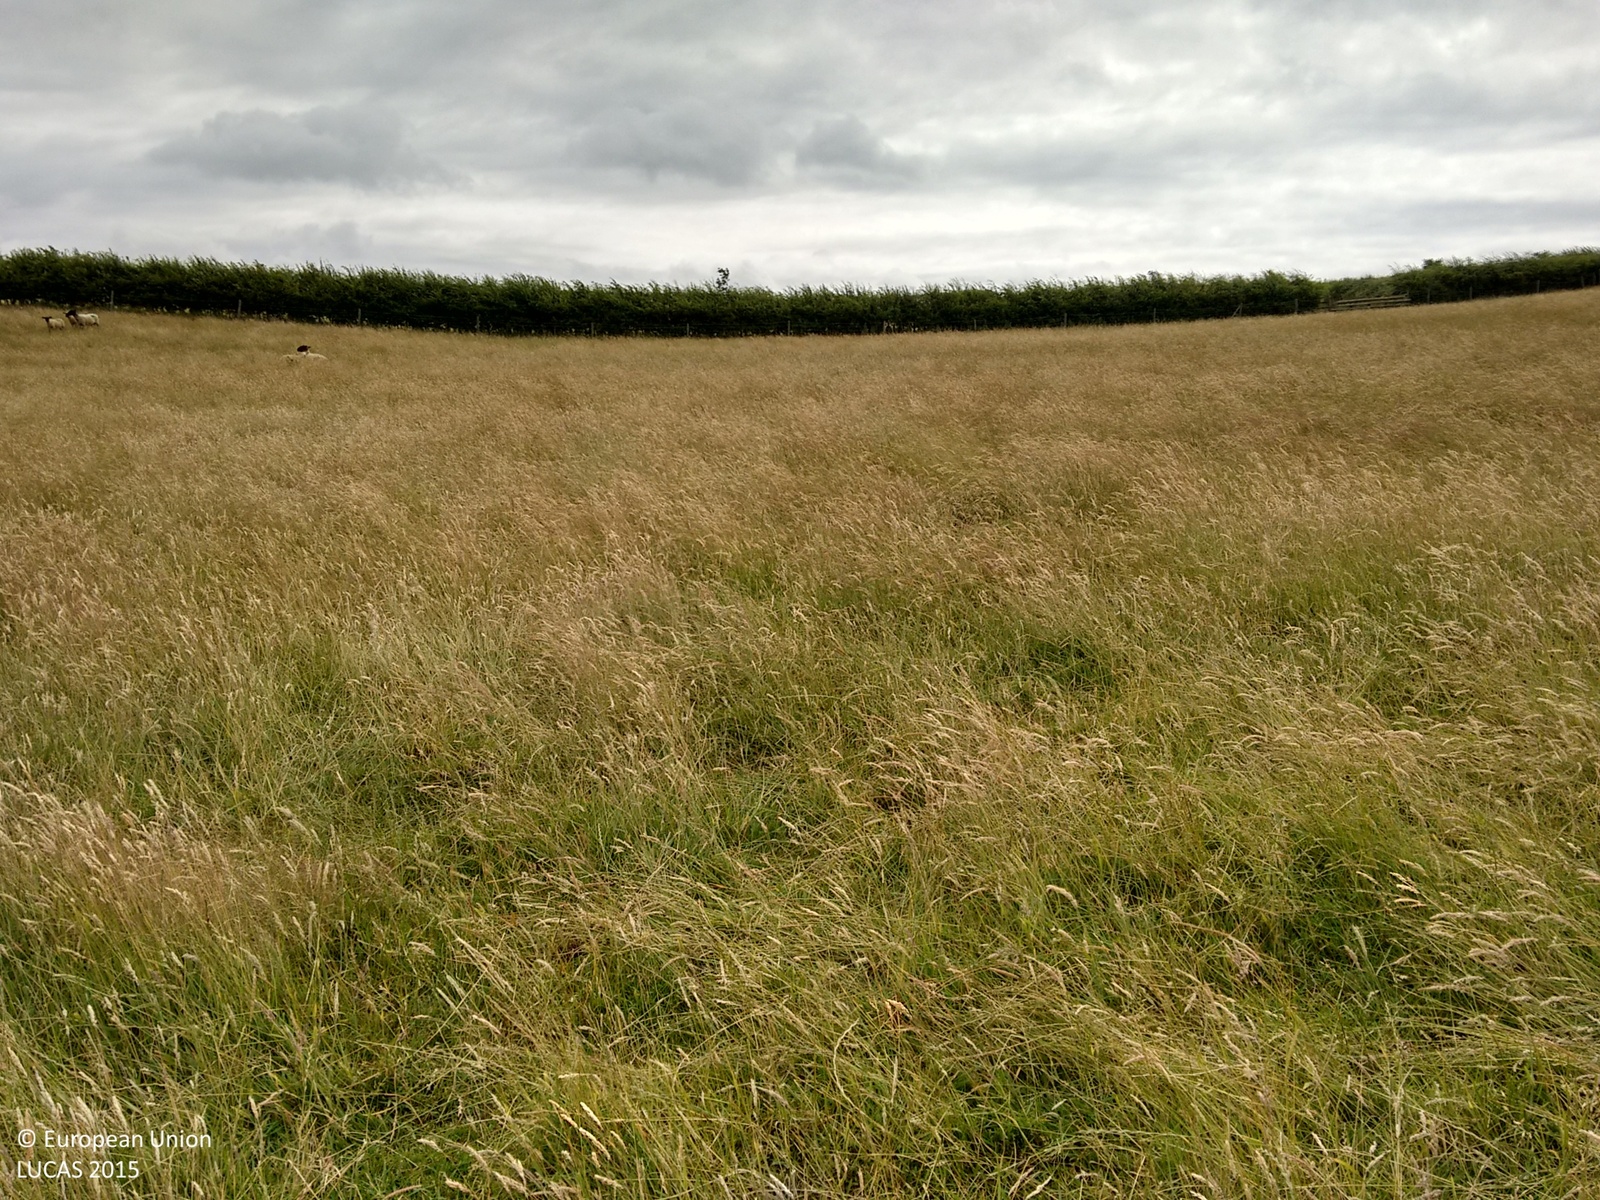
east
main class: Grassland
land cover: Grassland without tree/shrub cover
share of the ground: > 75 %
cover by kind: herbaceous plants 100 %
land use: Agriculture (excluding fallow land and kitchen gardens)
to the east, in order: Grassland without tree/shrub cover; Fences; Managed hedges; Fences; Grassland without tree/shrub cover
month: July
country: GB
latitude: 52.6562
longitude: -0.8787
